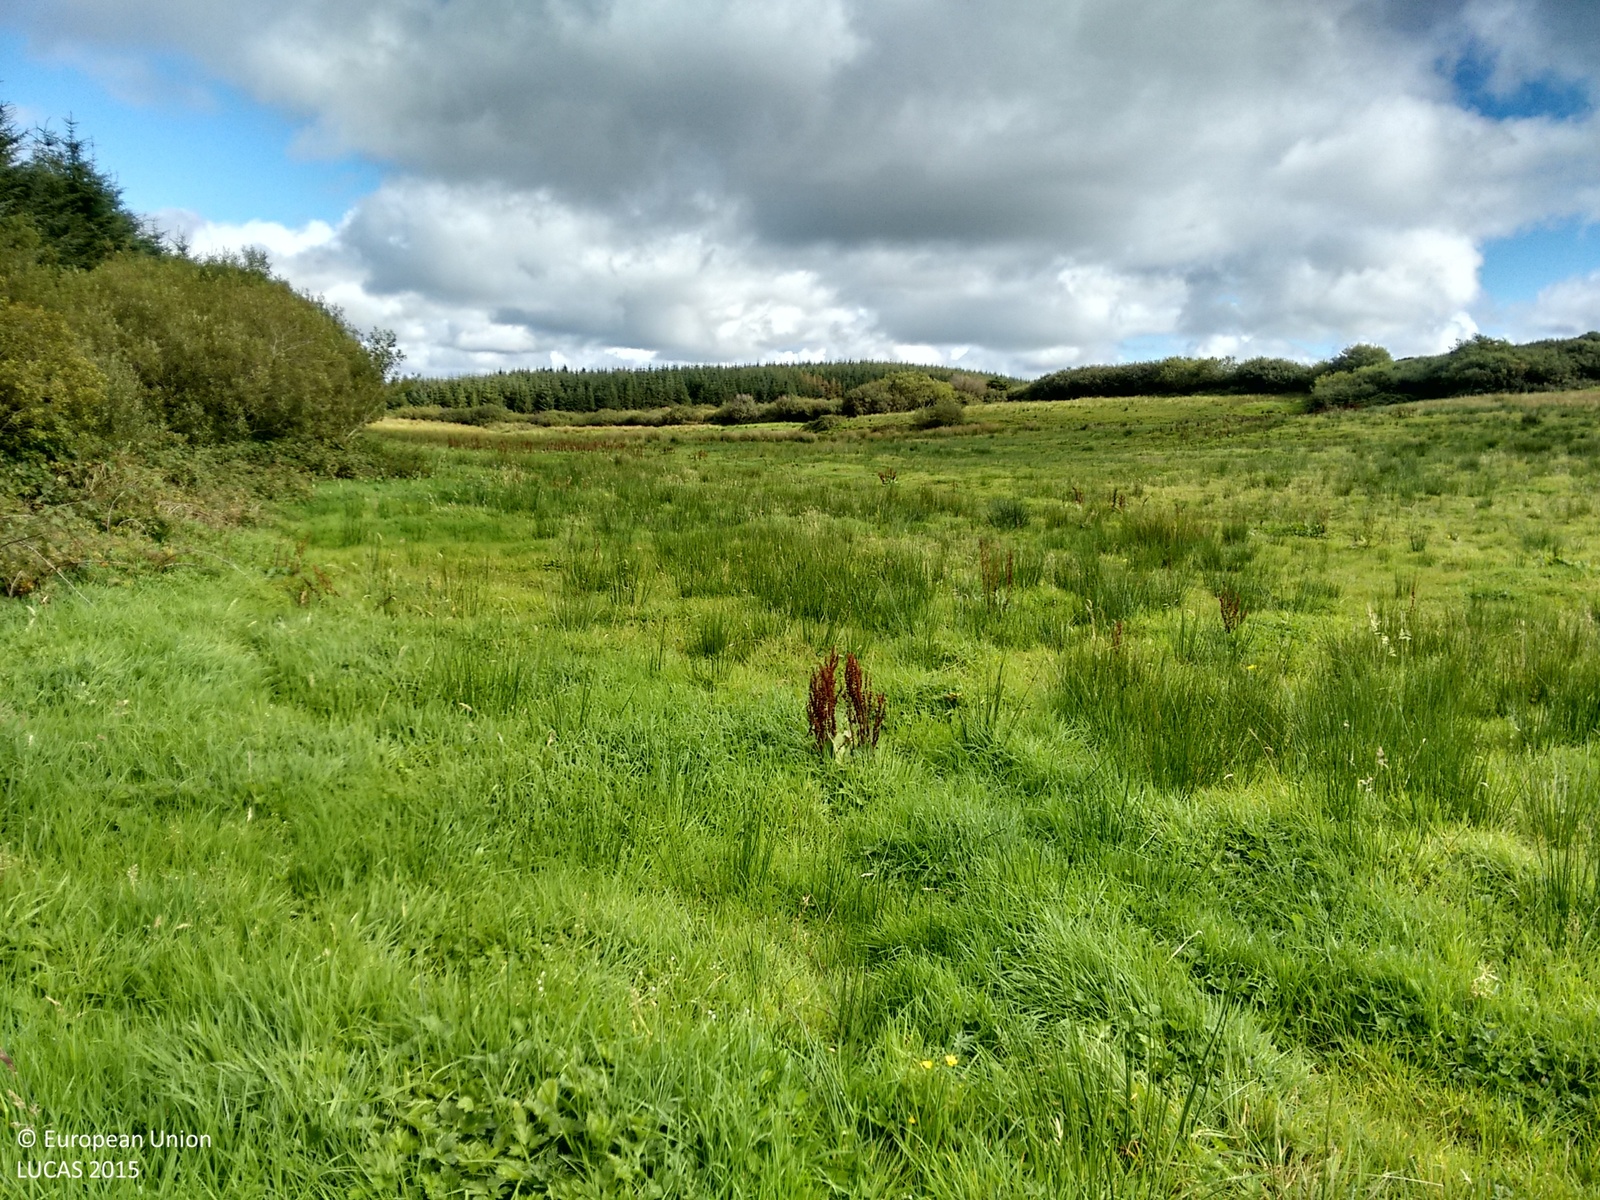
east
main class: Grassland
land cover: Grassland without tree/shrub cover
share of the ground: > 75 %
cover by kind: herbaceous plants 95 %
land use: Agriculture (excluding fallow land and kitchen gardens)
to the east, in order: Grassland without tree/shrub cover; Shruby margins; Ditches and canals; Broadleaved woodland; Grassland without tree/shrub cover
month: September
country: IE
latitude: 52.9201
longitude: -9.1834
